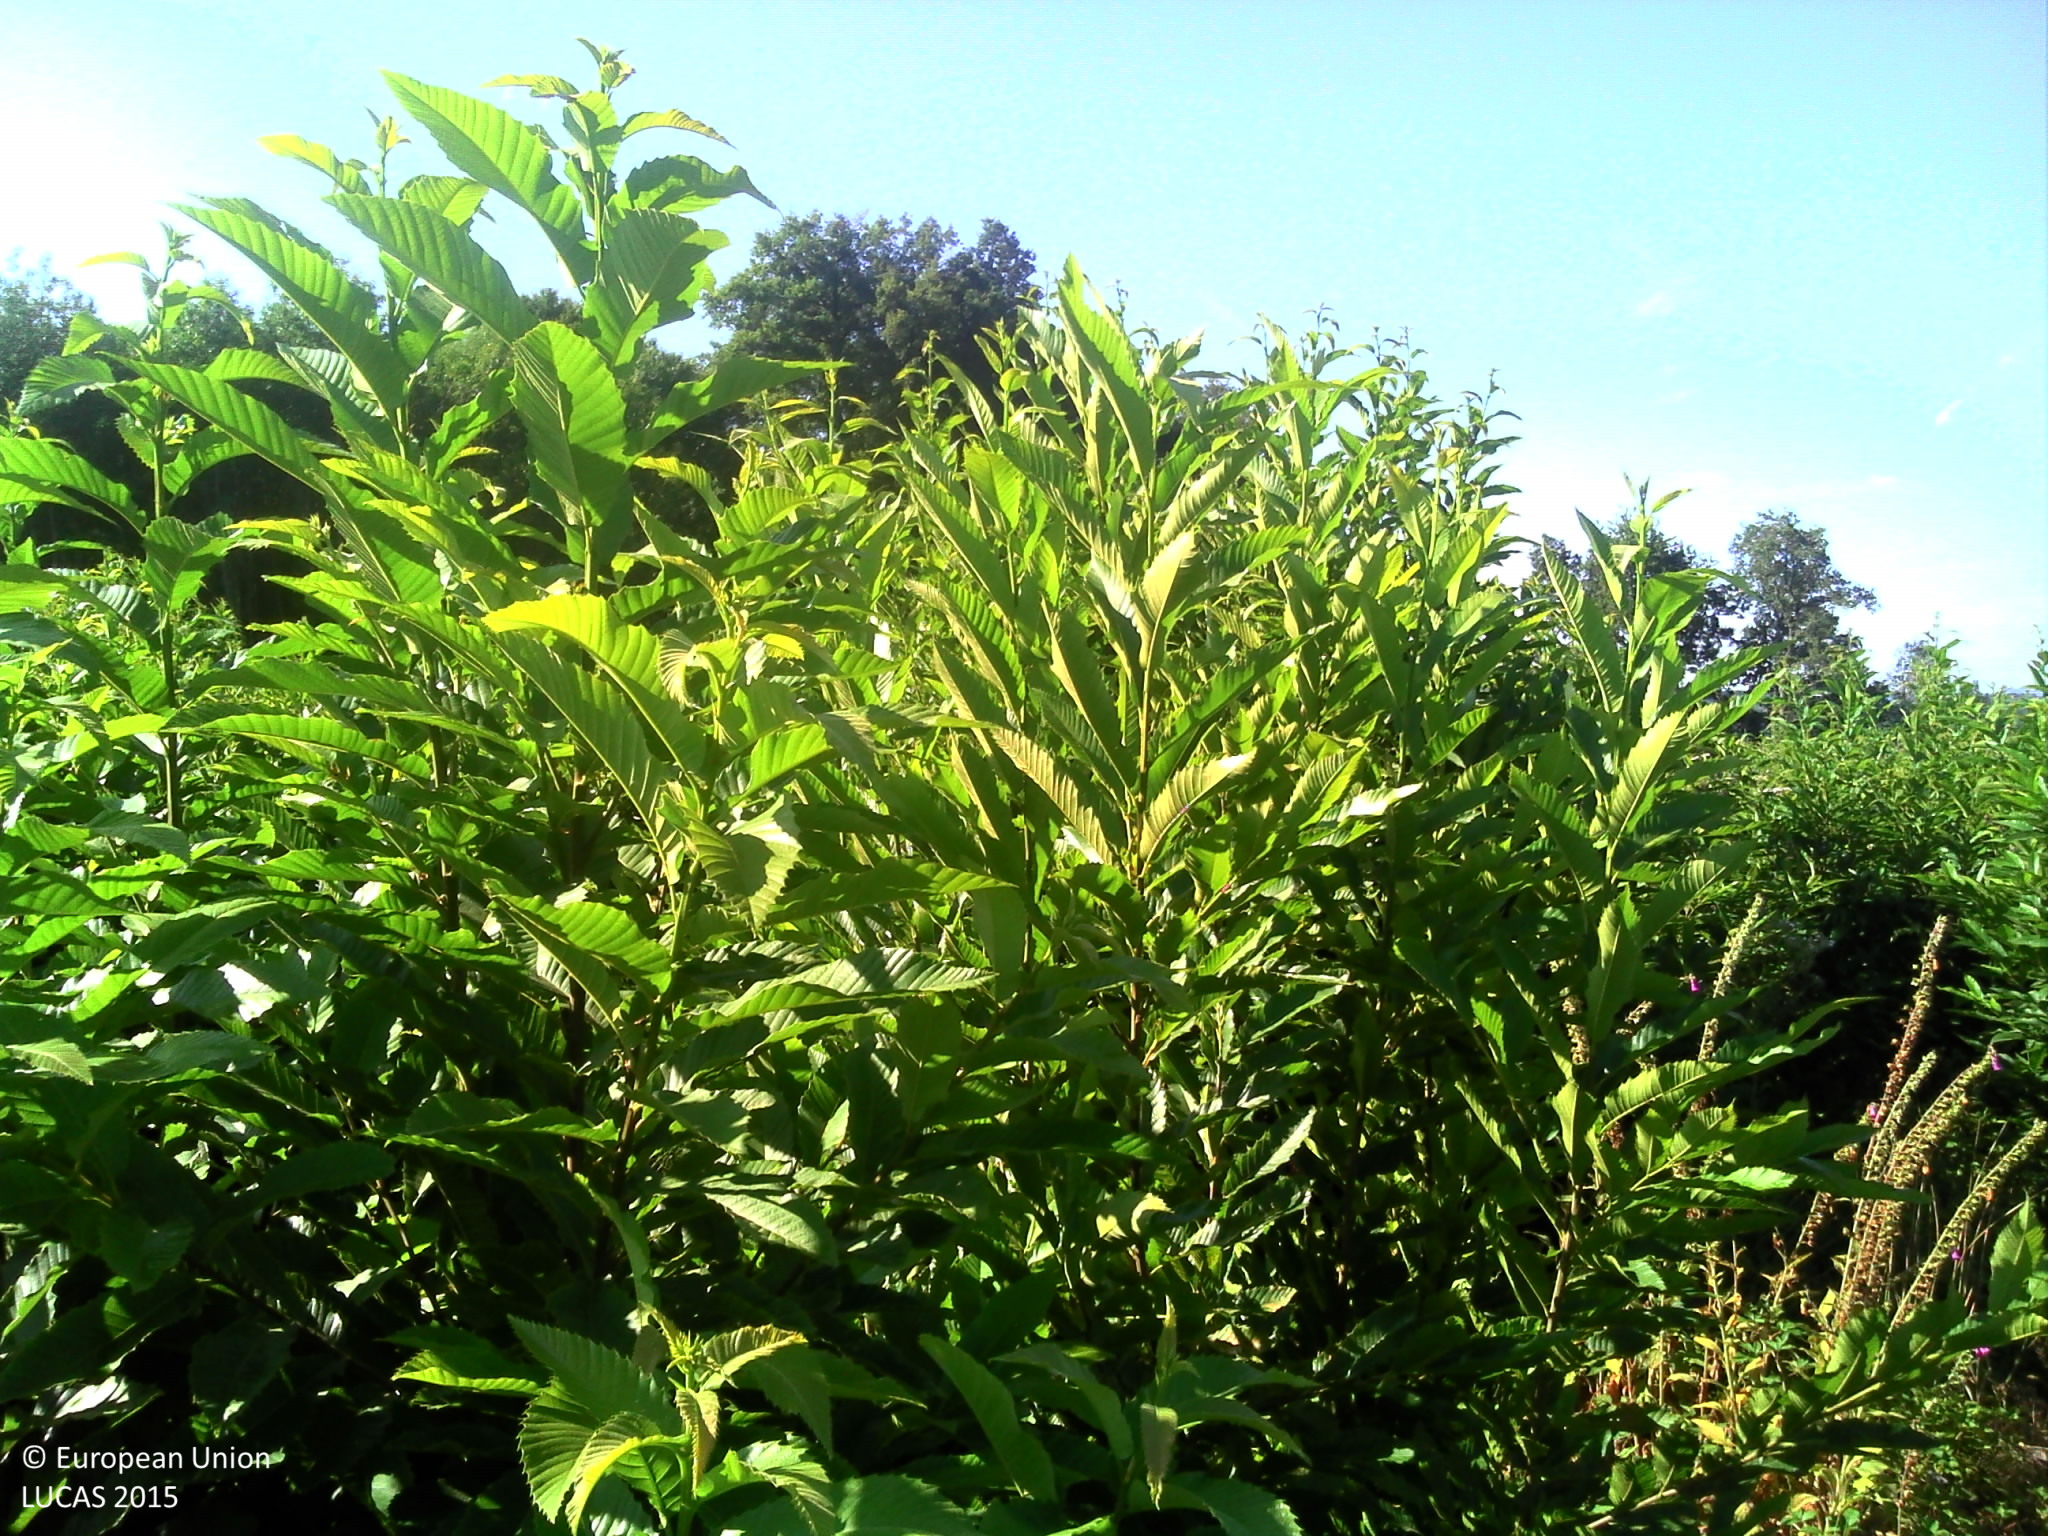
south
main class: Shrubland
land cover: Shrubland with sparse tree cover
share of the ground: > 75 %
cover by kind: shrubs 90 %, broadleaved forest trees 5 %, herbaceous plants 5 %
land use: Forestry
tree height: < 5 m
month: July
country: FR
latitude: 46.1999
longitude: 1.5808
